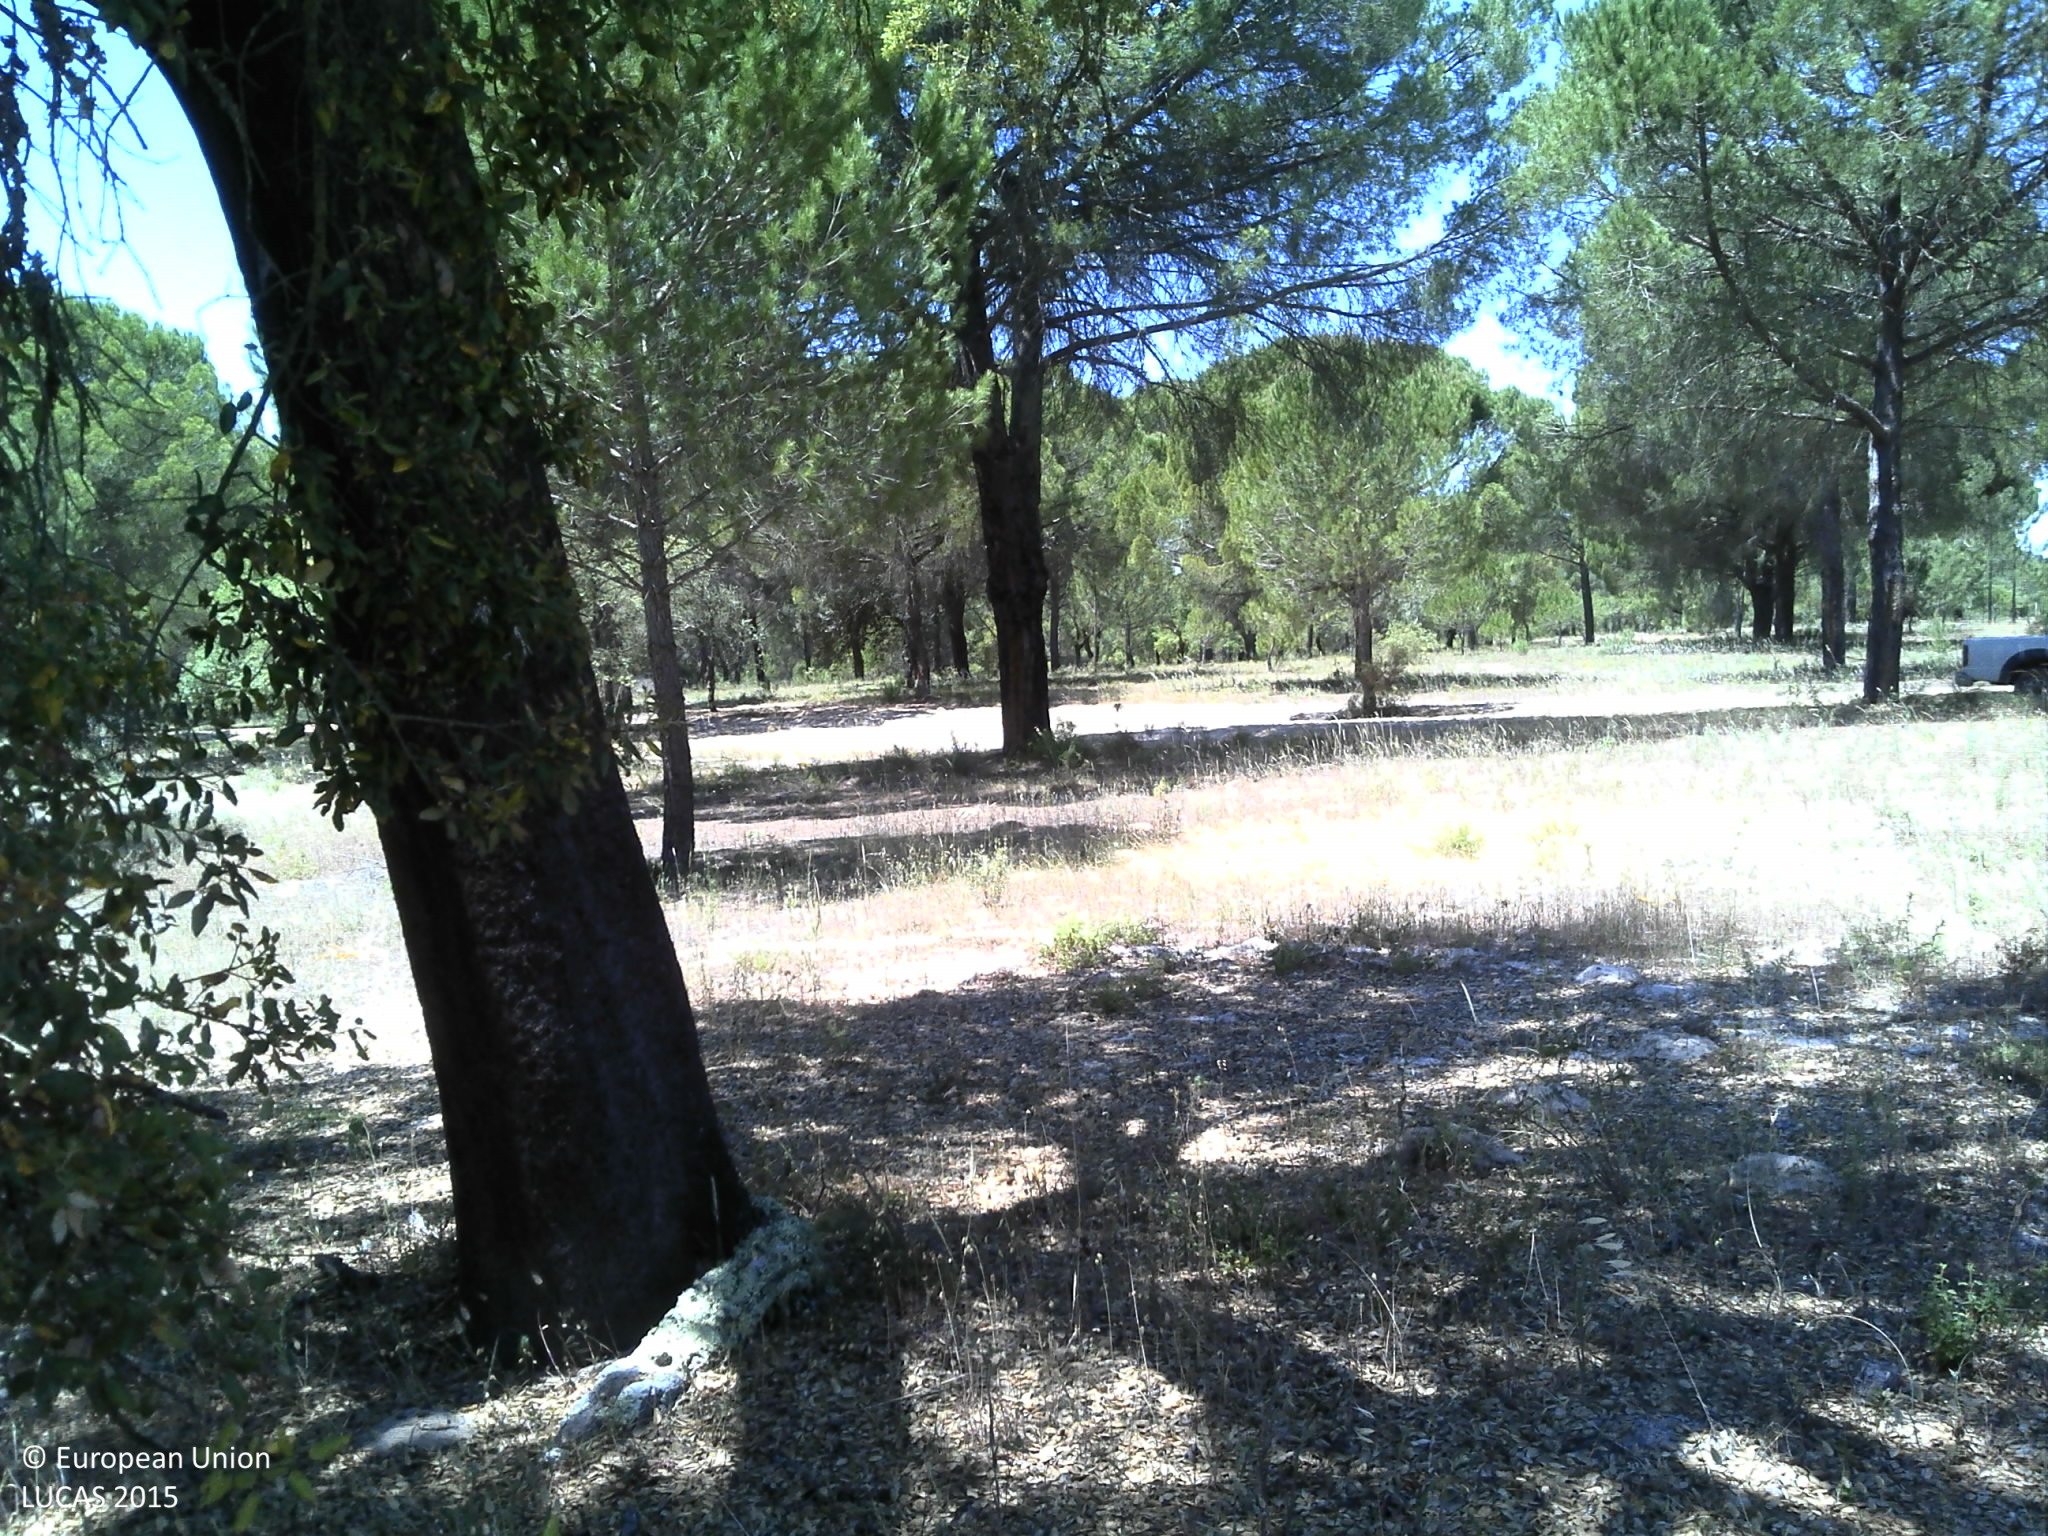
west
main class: Woodland
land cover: Broadleaved woodland
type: broadleaved evergreen forest
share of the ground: 50 - 75 %
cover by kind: broadleaved forest trees 50 %, unconsolidated bare surface 30 %, herbaceous plants 20 %
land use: Forestry
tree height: > 5 m
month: May
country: PT
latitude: 38.1703
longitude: -8.4334
